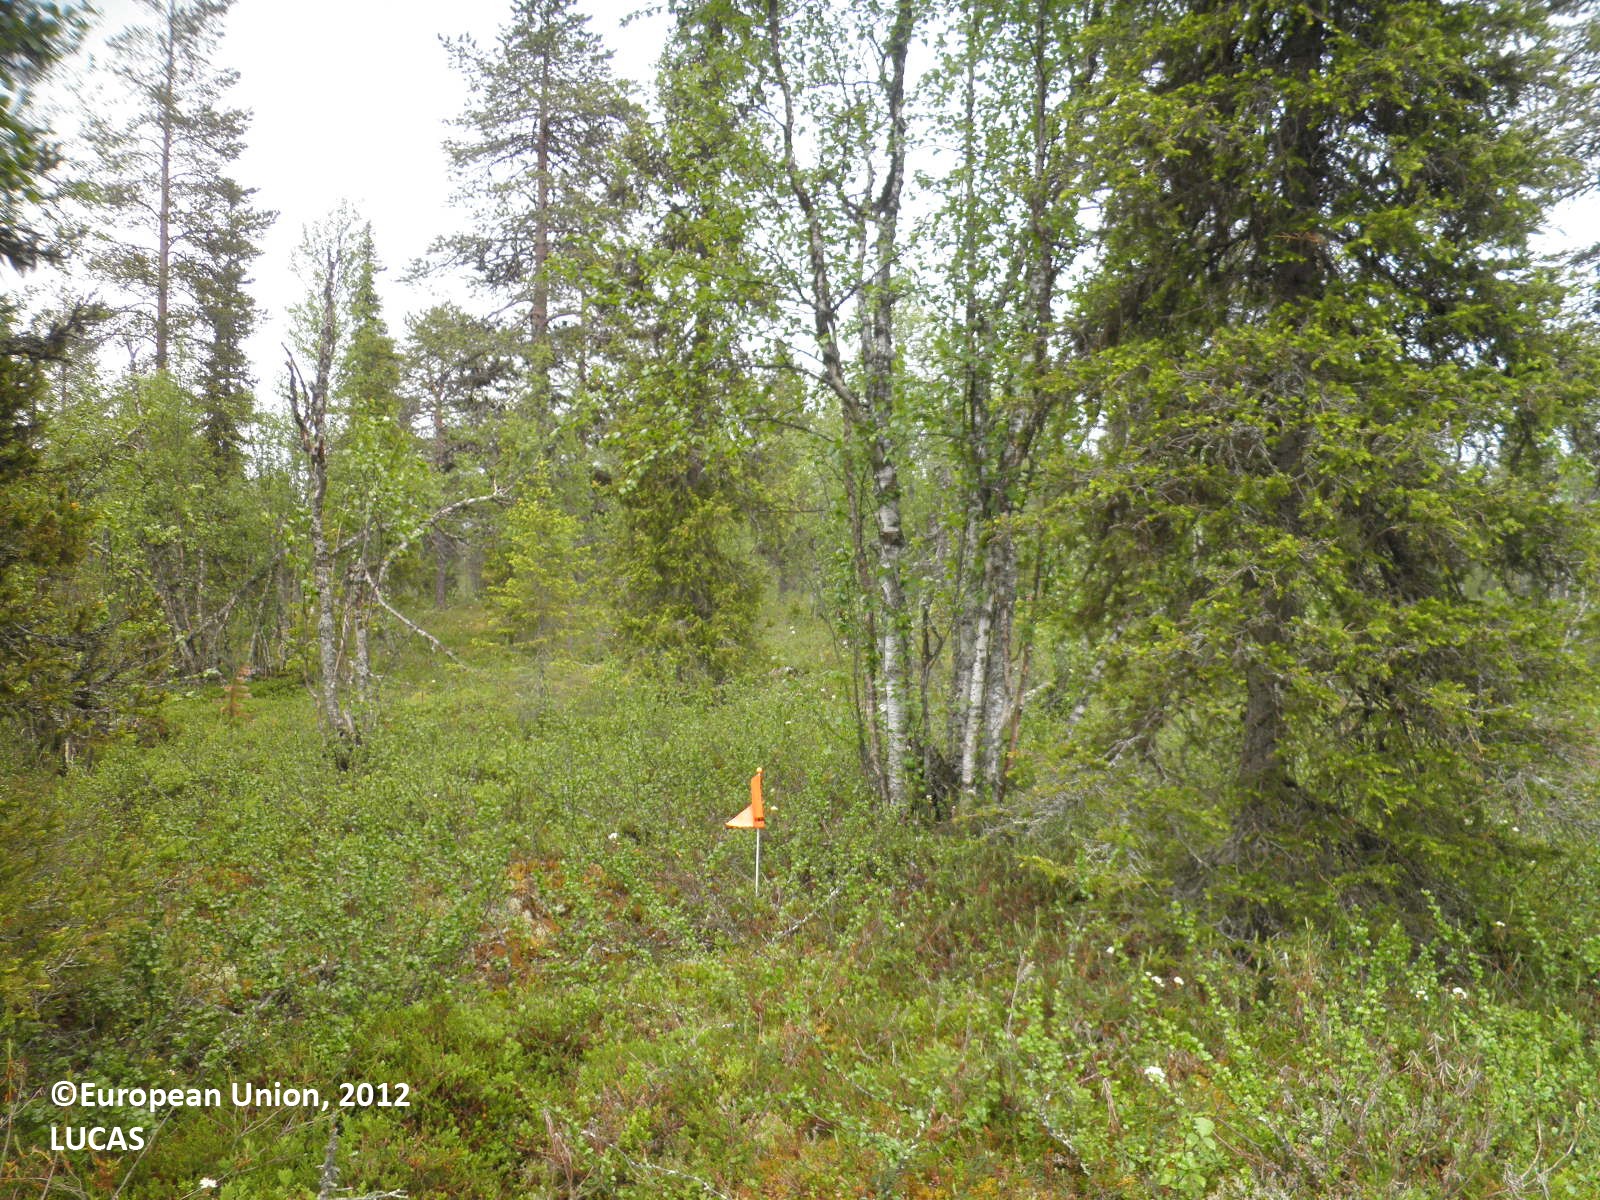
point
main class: Woodland
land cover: Other mixed woodland
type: boreal forest
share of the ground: 50 - 75 %
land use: Forestry
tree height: > 5 m
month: July
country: FI
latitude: 68.2175
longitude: 25.8125
